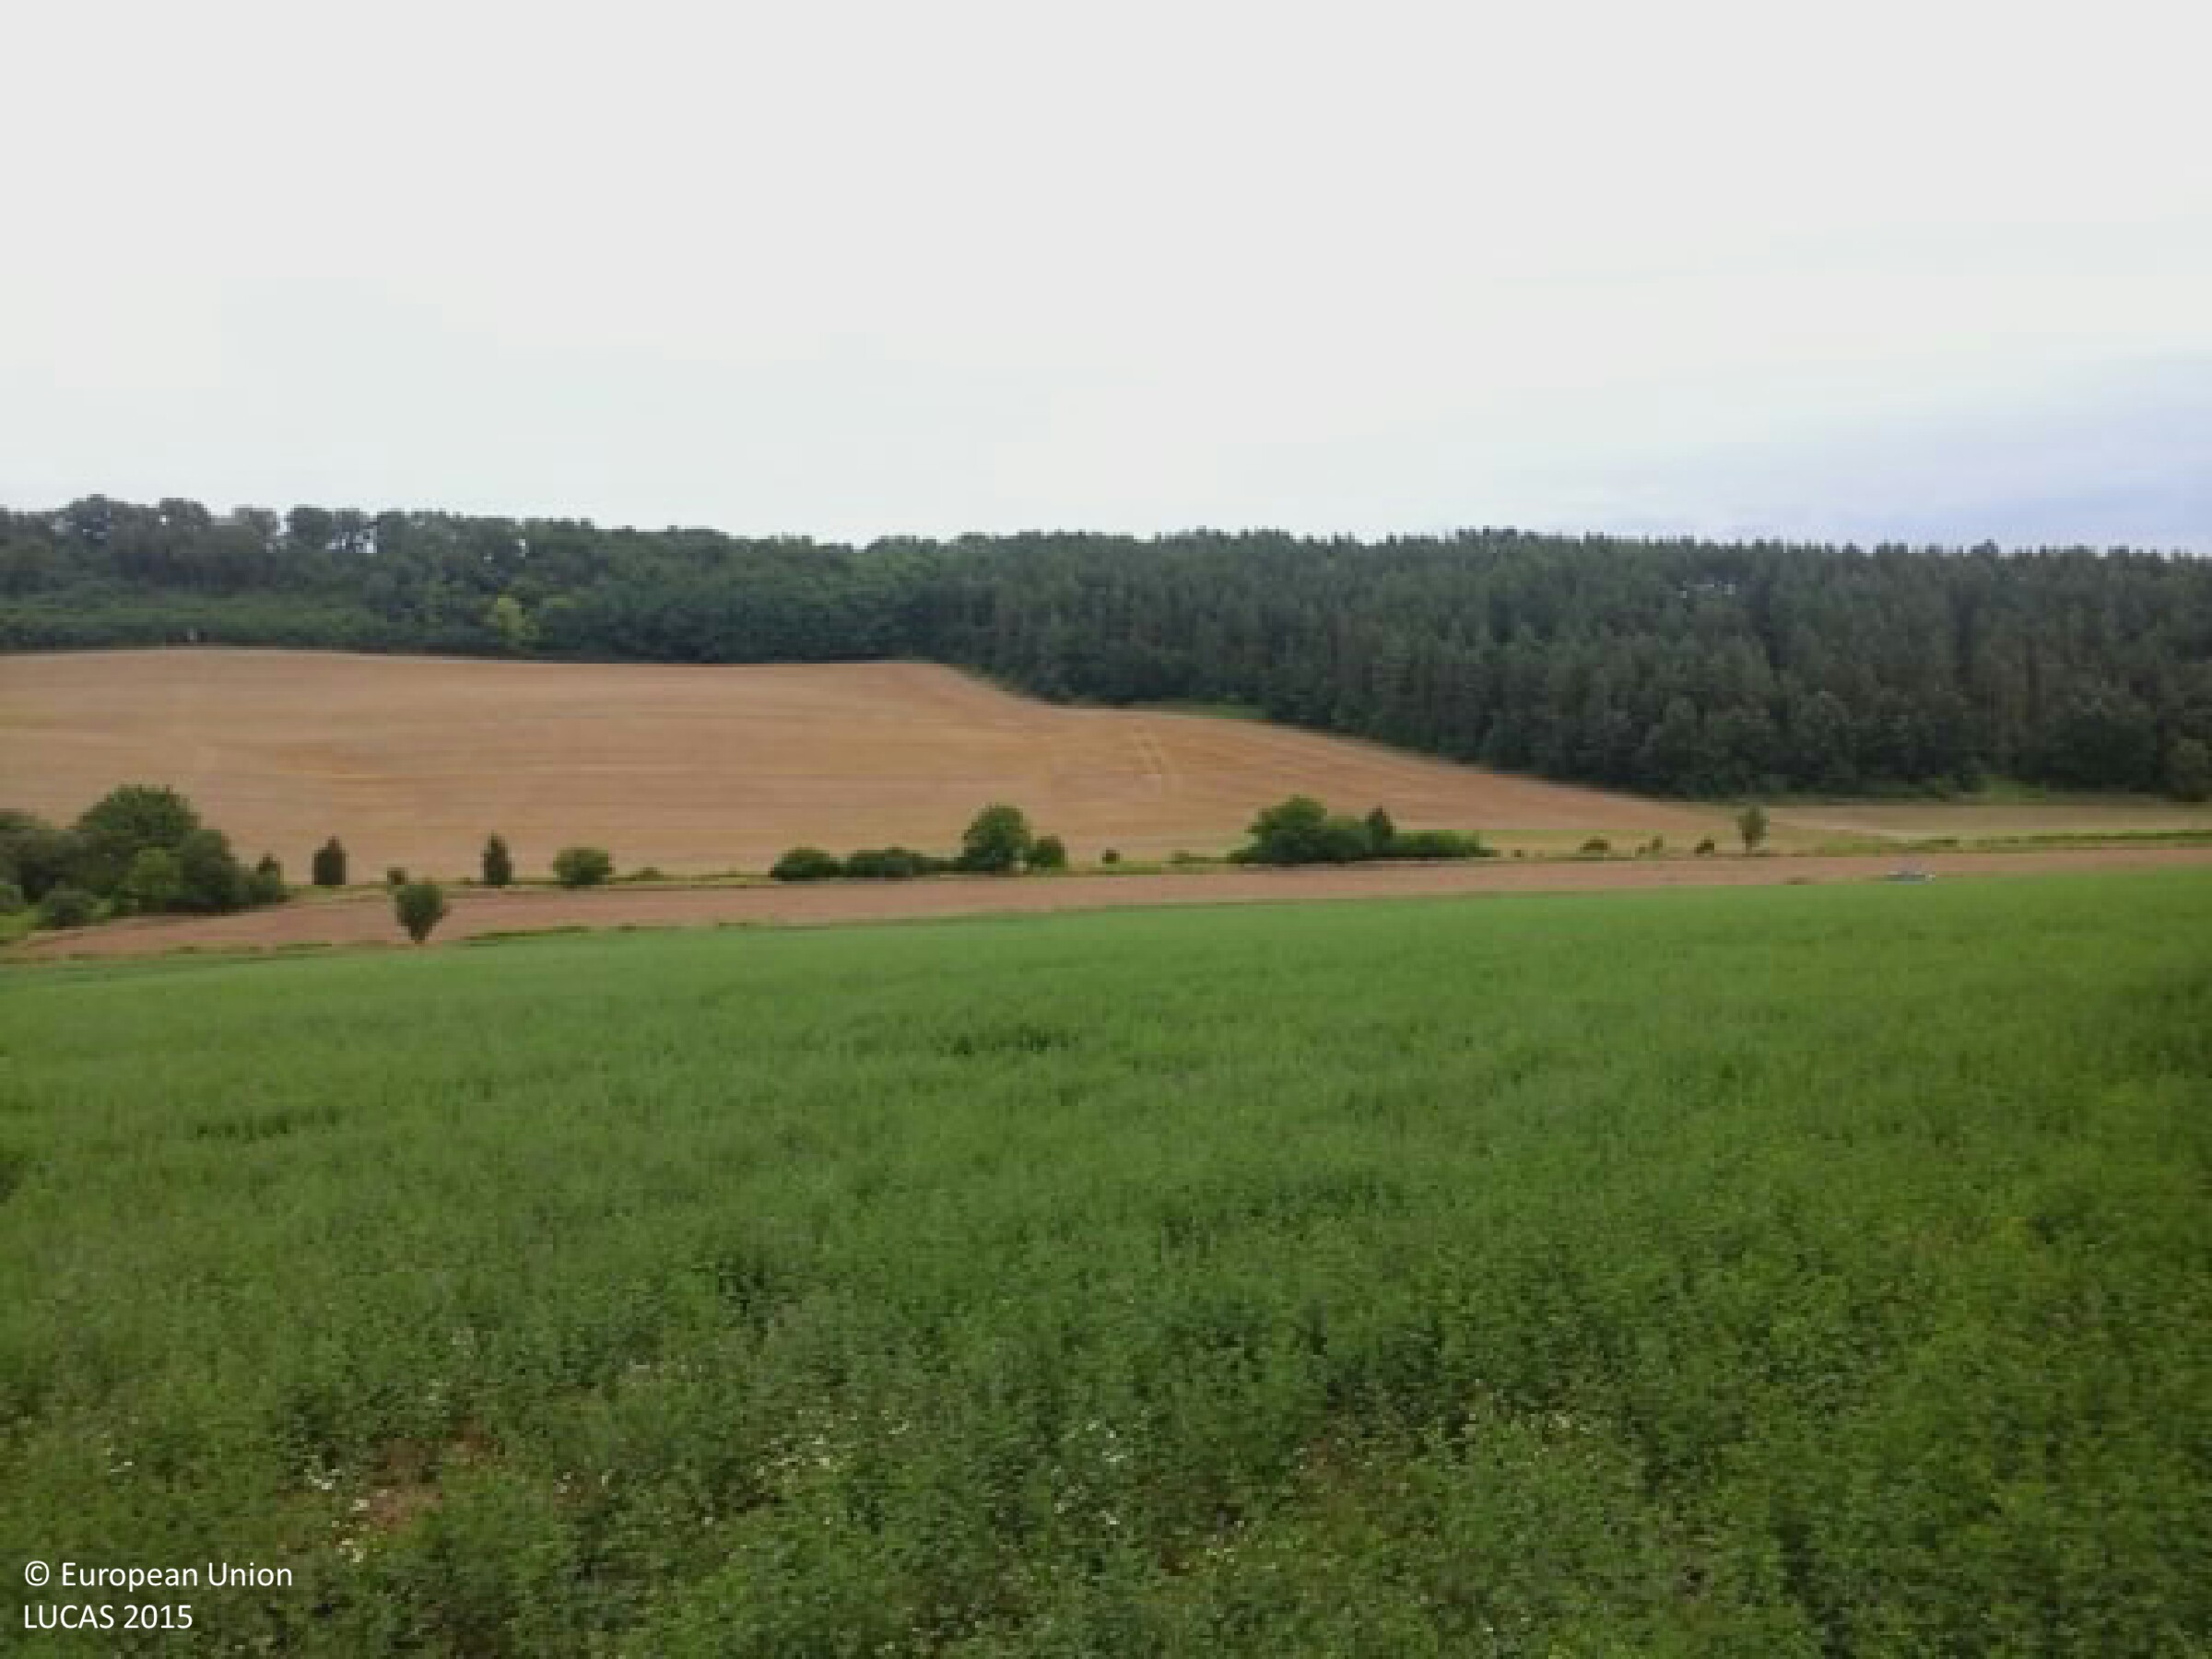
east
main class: Cropland
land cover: Lucerne
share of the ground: > 75 %
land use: Agriculture (excluding fallow land and kitchen gardens)
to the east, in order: Lucerne; Grass margins; Tracks; Grass margins; Other bare soil
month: July
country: HU
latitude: 46.2297
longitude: 18.0327
